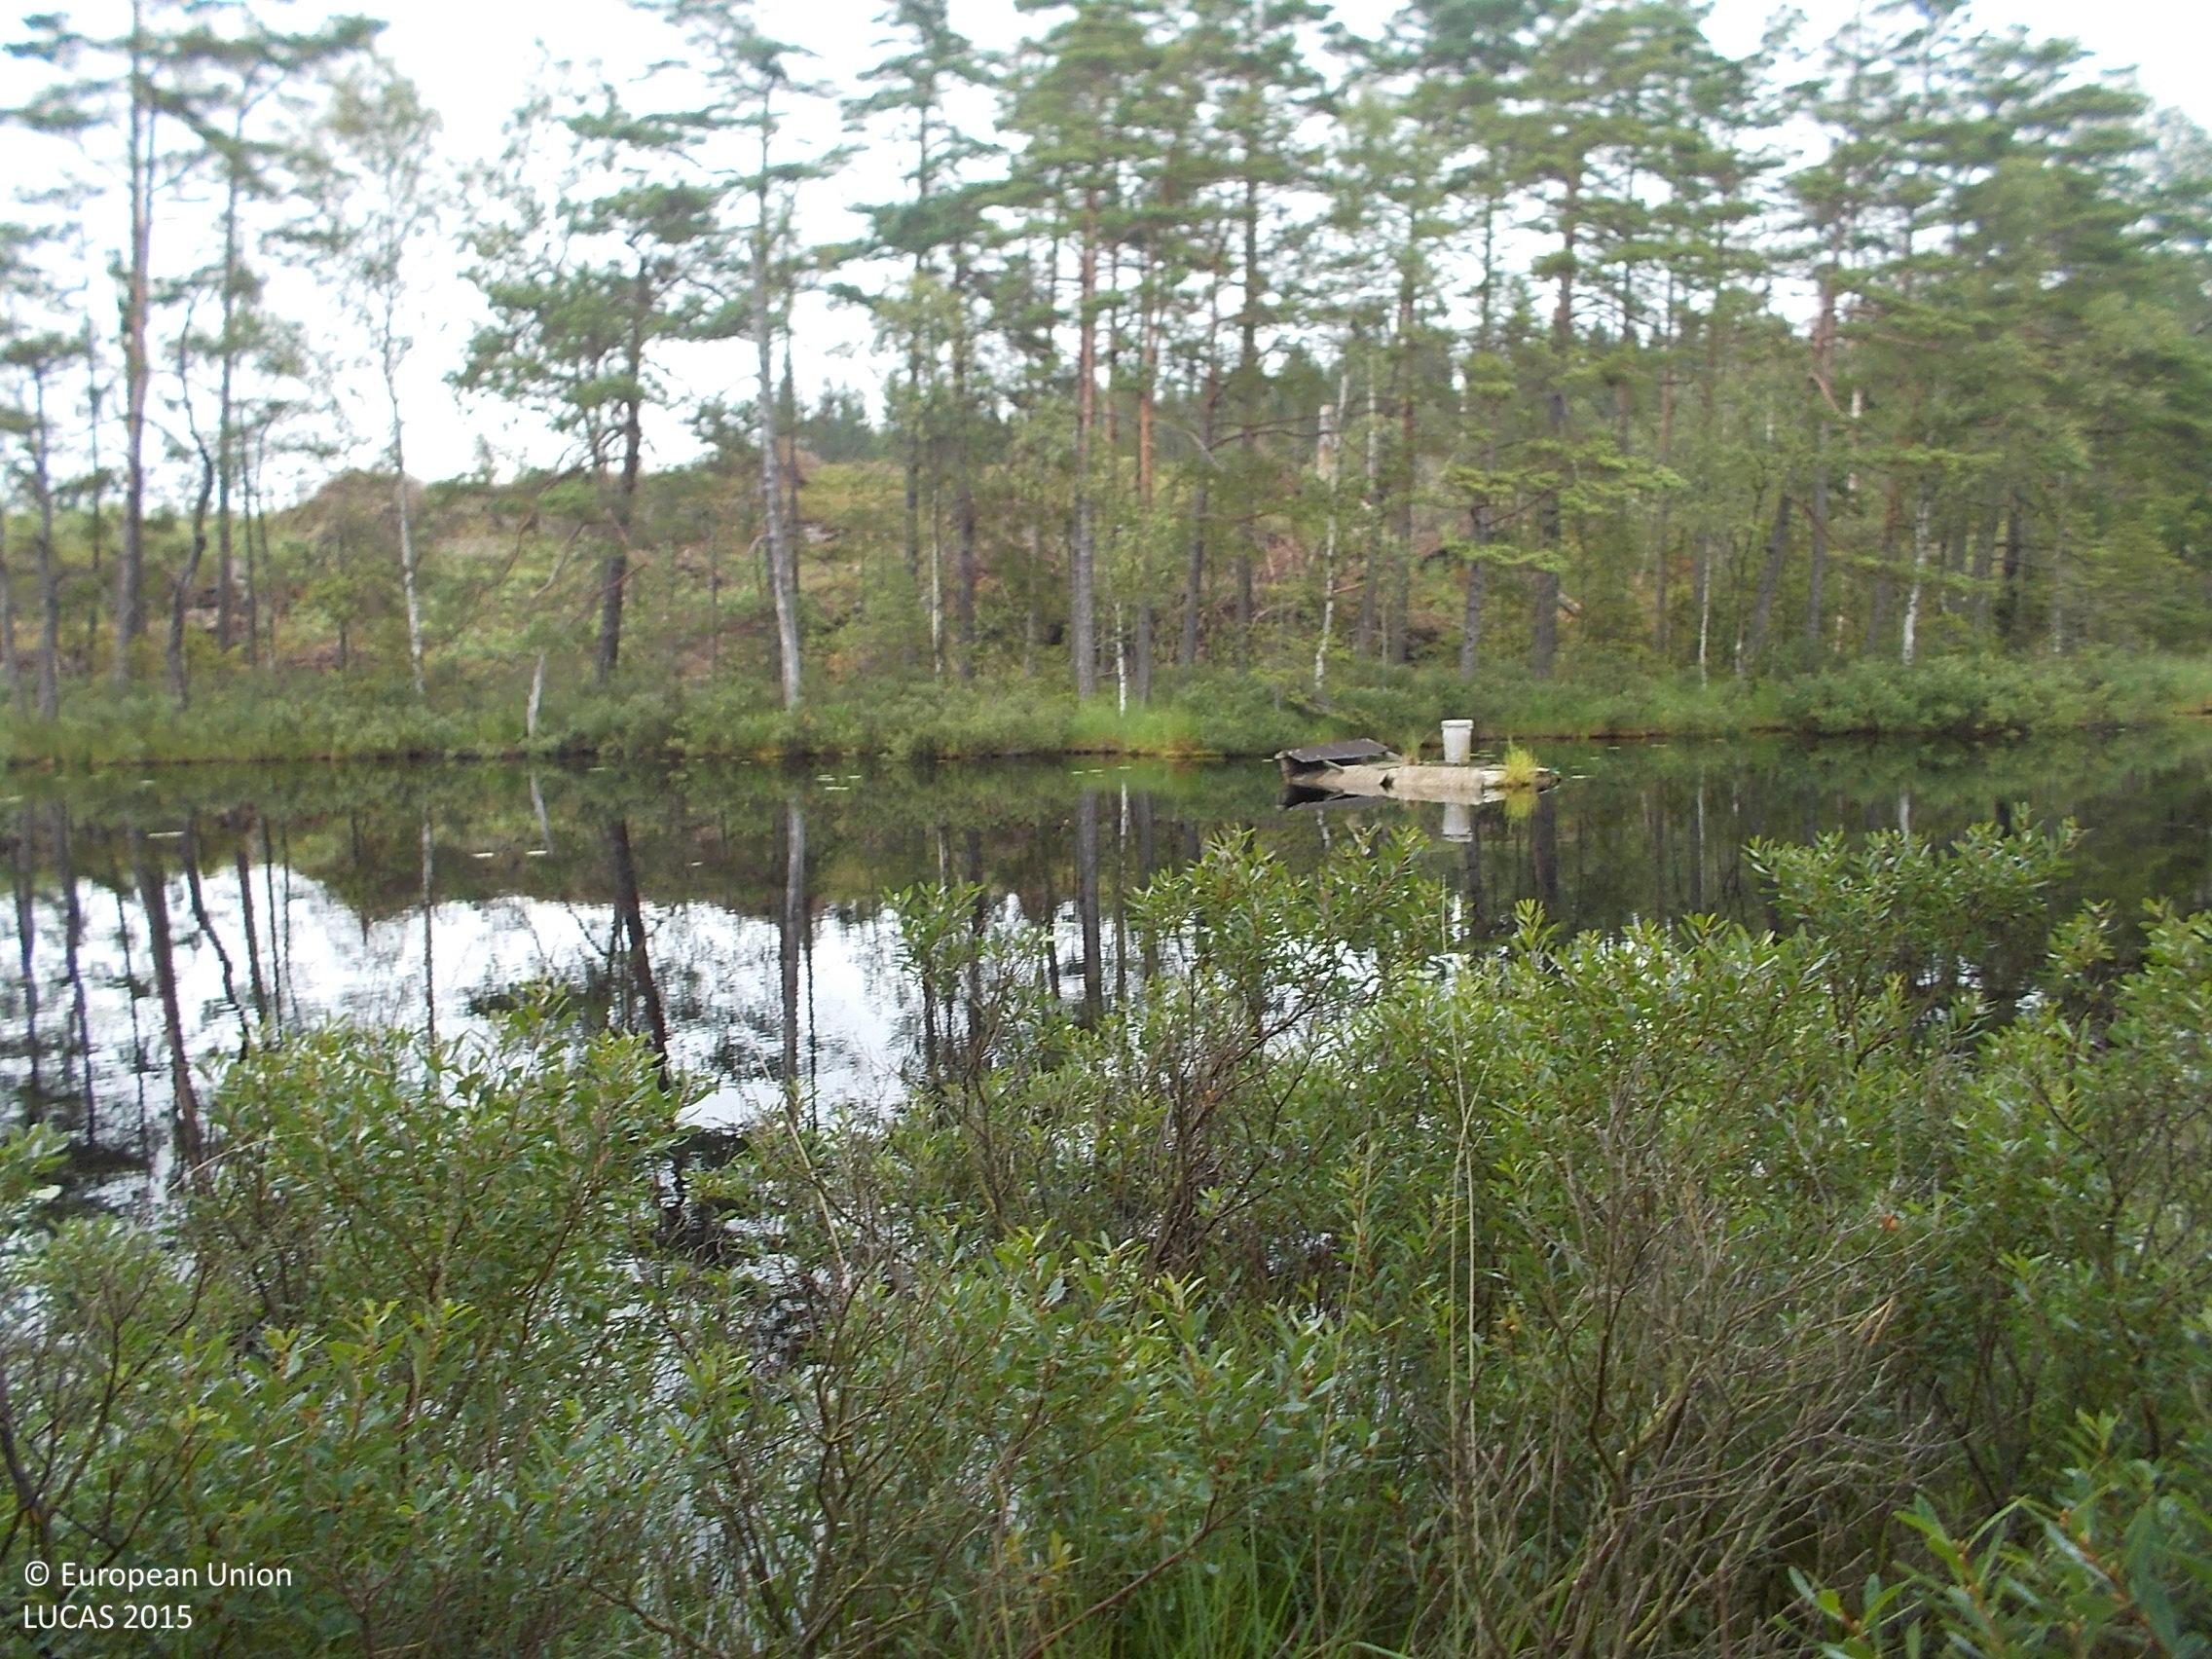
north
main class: Woodland
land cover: Pine dominated mixed woodland
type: boreal forest
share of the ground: > 75 %
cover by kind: coniferous forest trees 60 %, broadleaved forest trees 25 %, shrubs 10 %, lichens and mosses 5 %
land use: Semi-natural and natural areas not in use
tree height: > 5 m
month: August
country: SE
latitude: 57.5164
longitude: 12.2836
